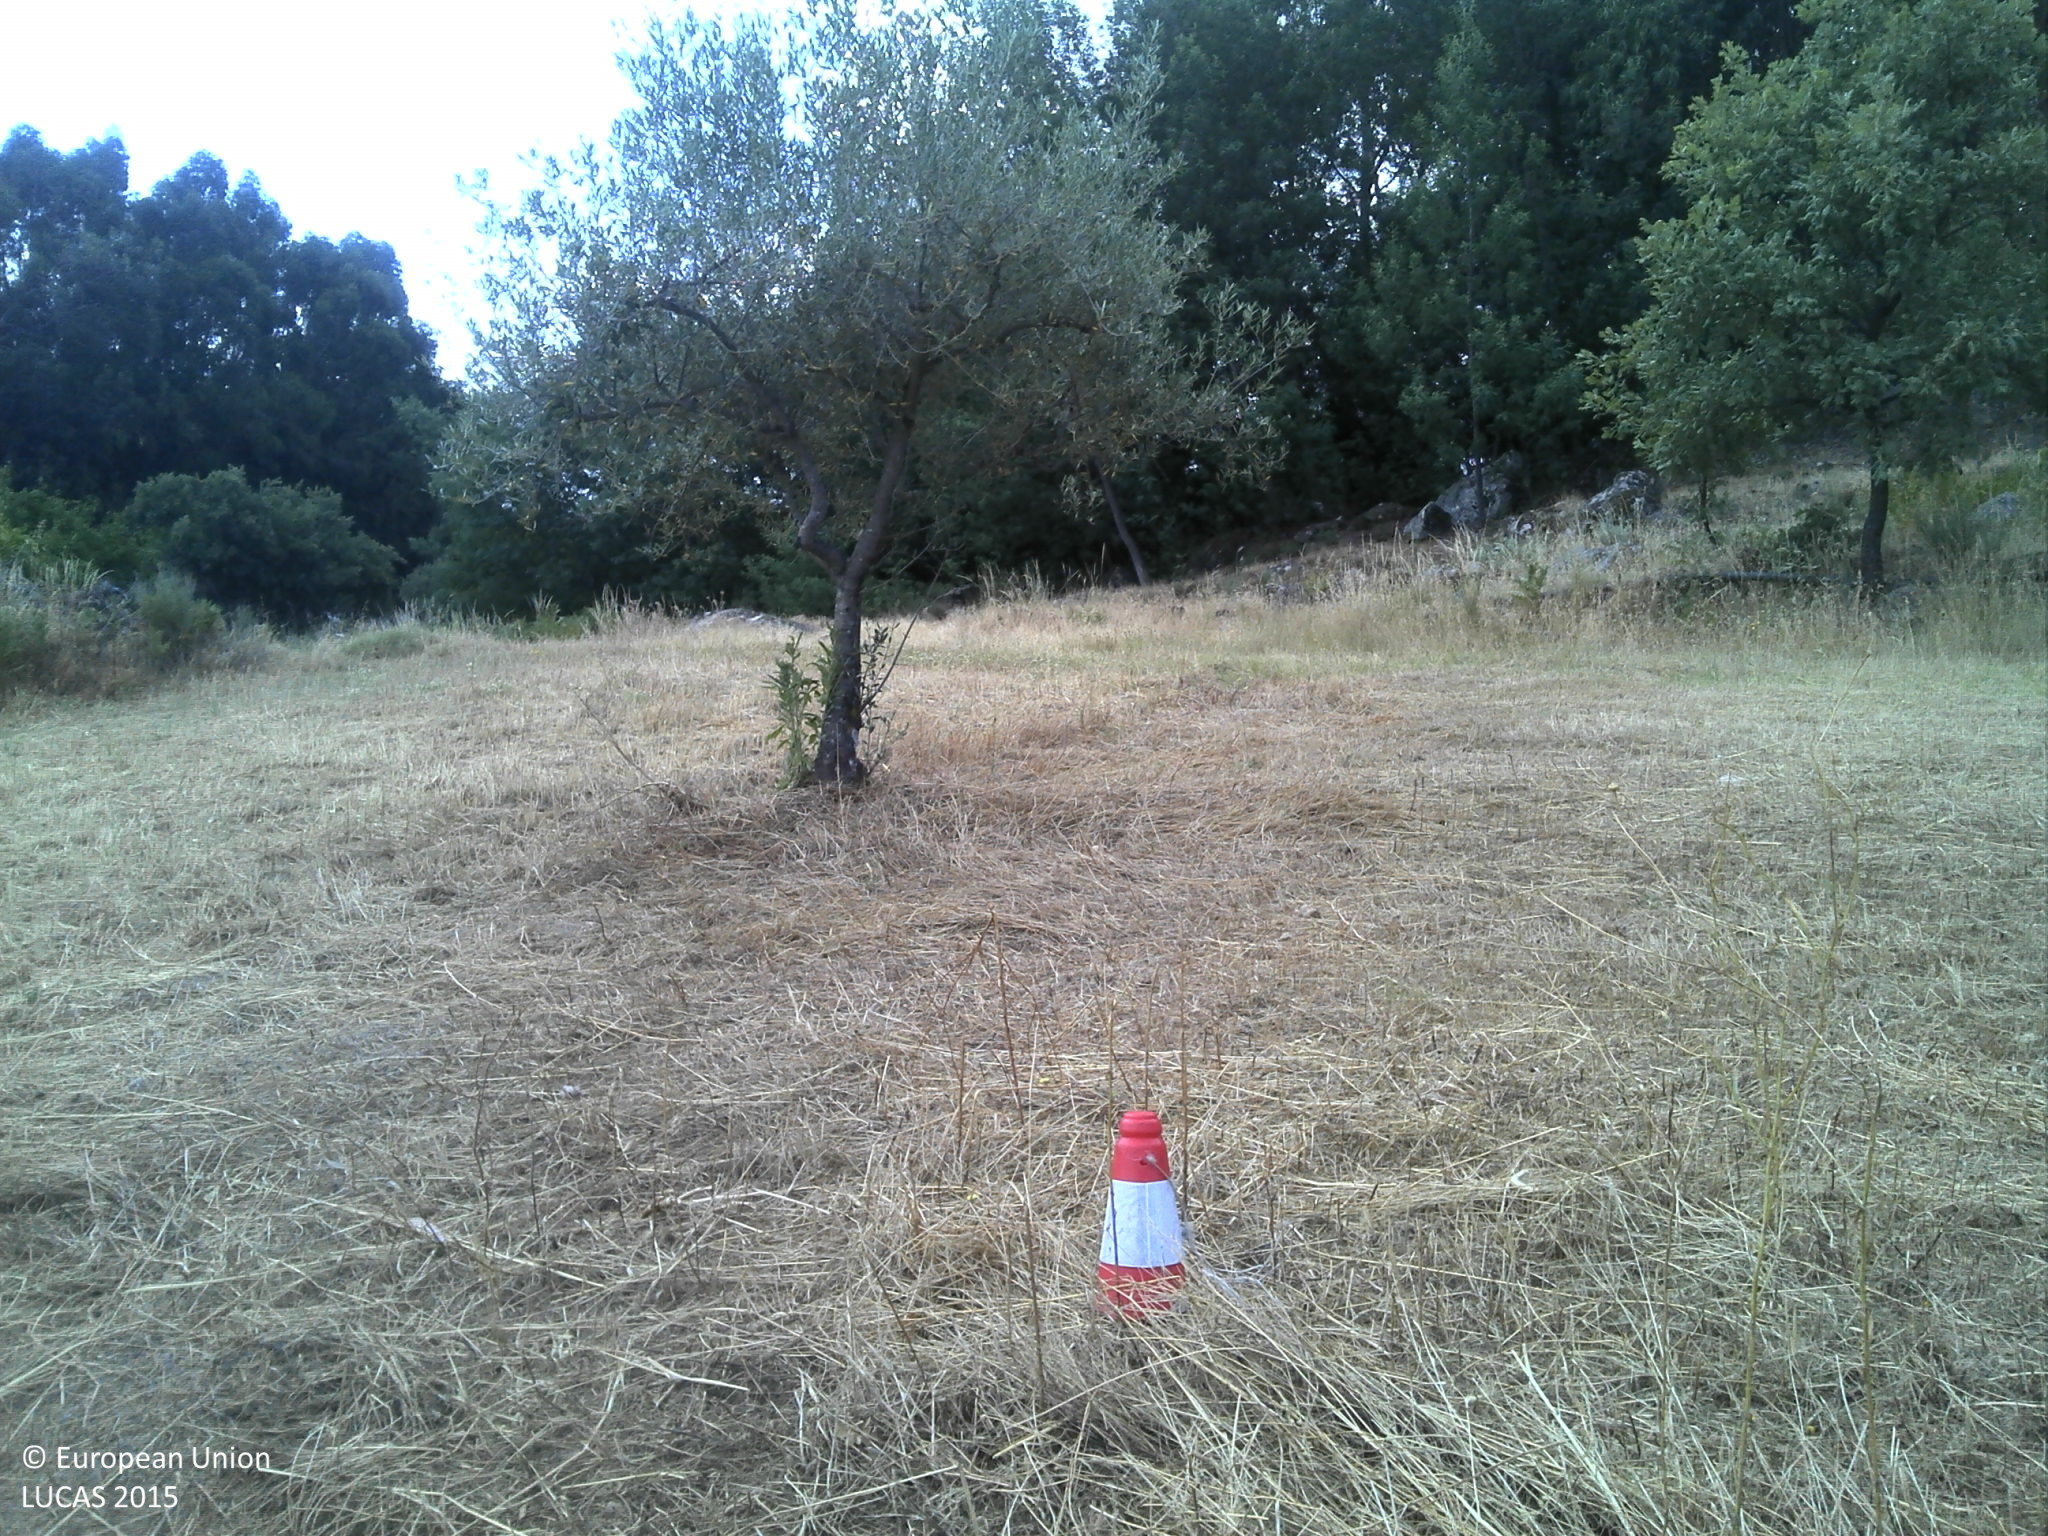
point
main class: Cropland
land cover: Olive groves
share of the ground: 10 - 25 %
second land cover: Spontaneously vegetated surfaces
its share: < 10 %
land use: Agriculture (excluding fallow land and kitchen gardens)
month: June
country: PT
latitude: 40.1348
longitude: -7.3175
